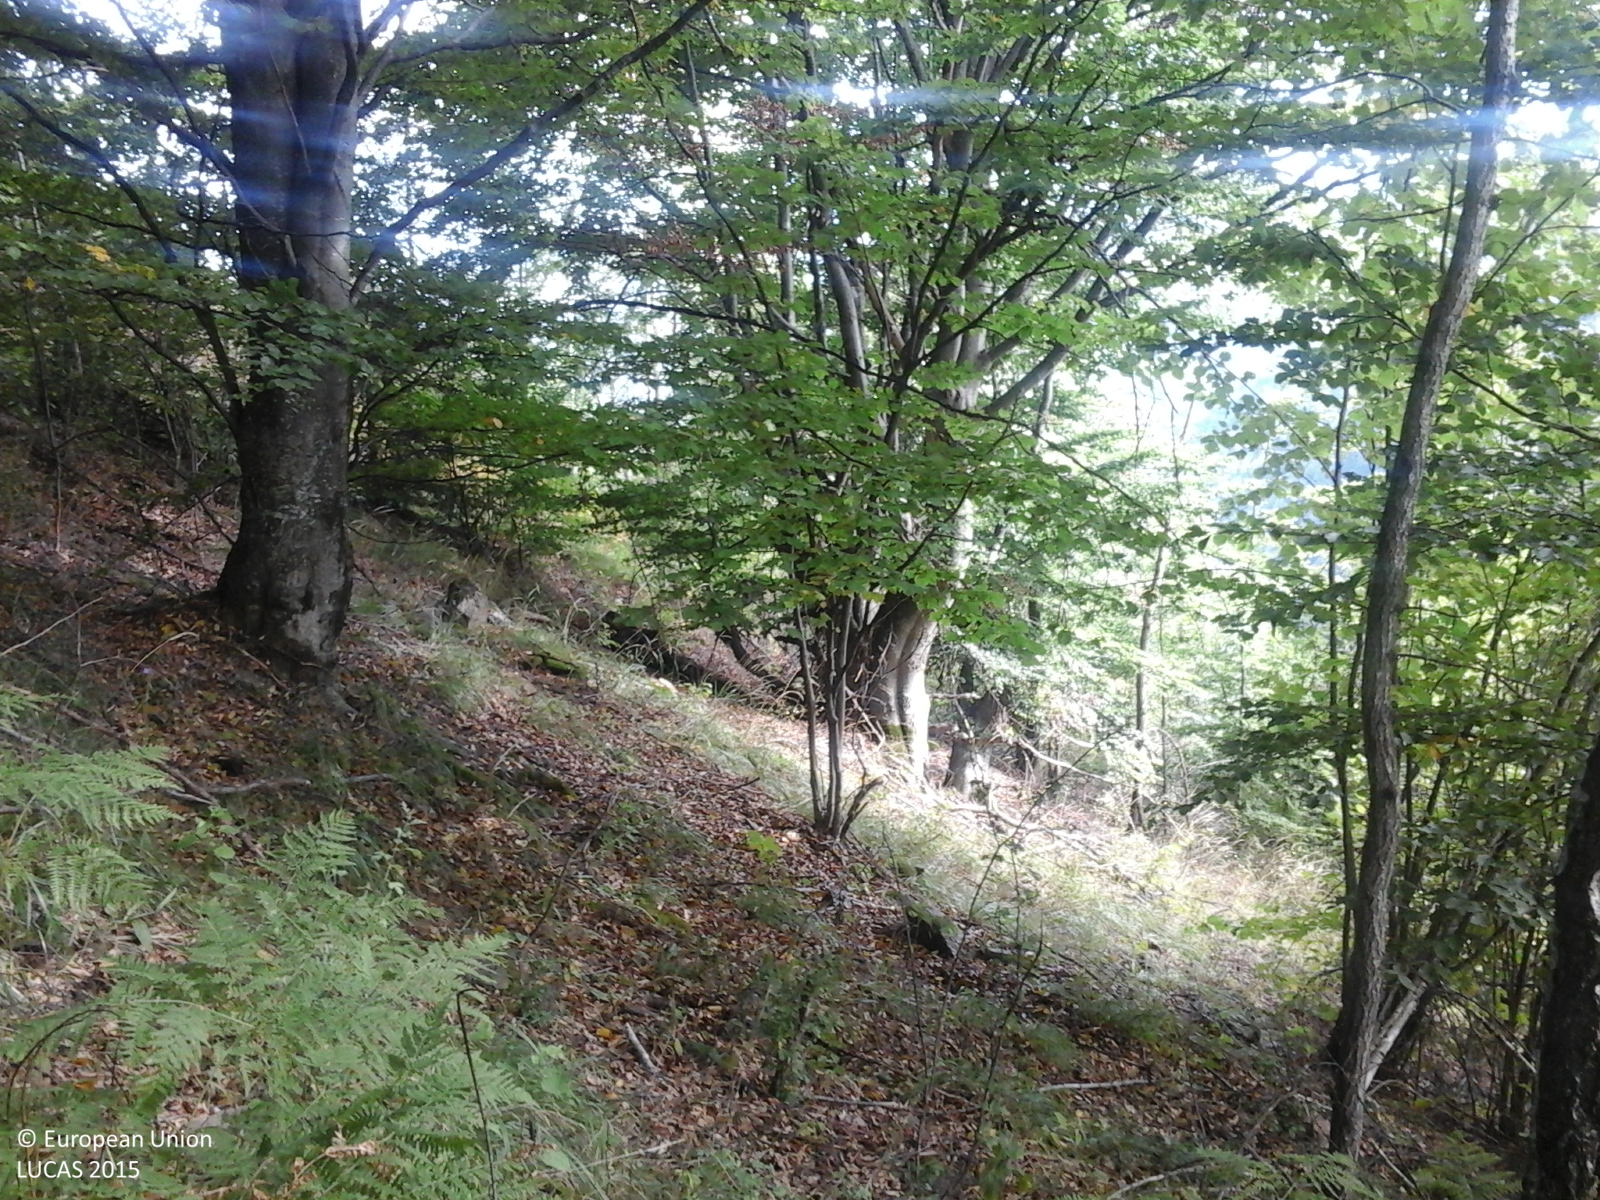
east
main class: Woodland
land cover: Broadleaved woodland
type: mesophytic deciduous forest
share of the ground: > 75 %
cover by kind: broadleaved forest trees 100 %
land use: Forestry
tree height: > 5 m
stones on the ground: > 50 %
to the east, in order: Broadleaved woodland; Fences; Grassland without tree/shrub cover; Tracks; Grassland without tree/shrub cover; Broadleaved woodland; Grassland without tree/shrub cover; Broadleaved woodland
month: October
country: RO
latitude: 46.6632
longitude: 23.1717
